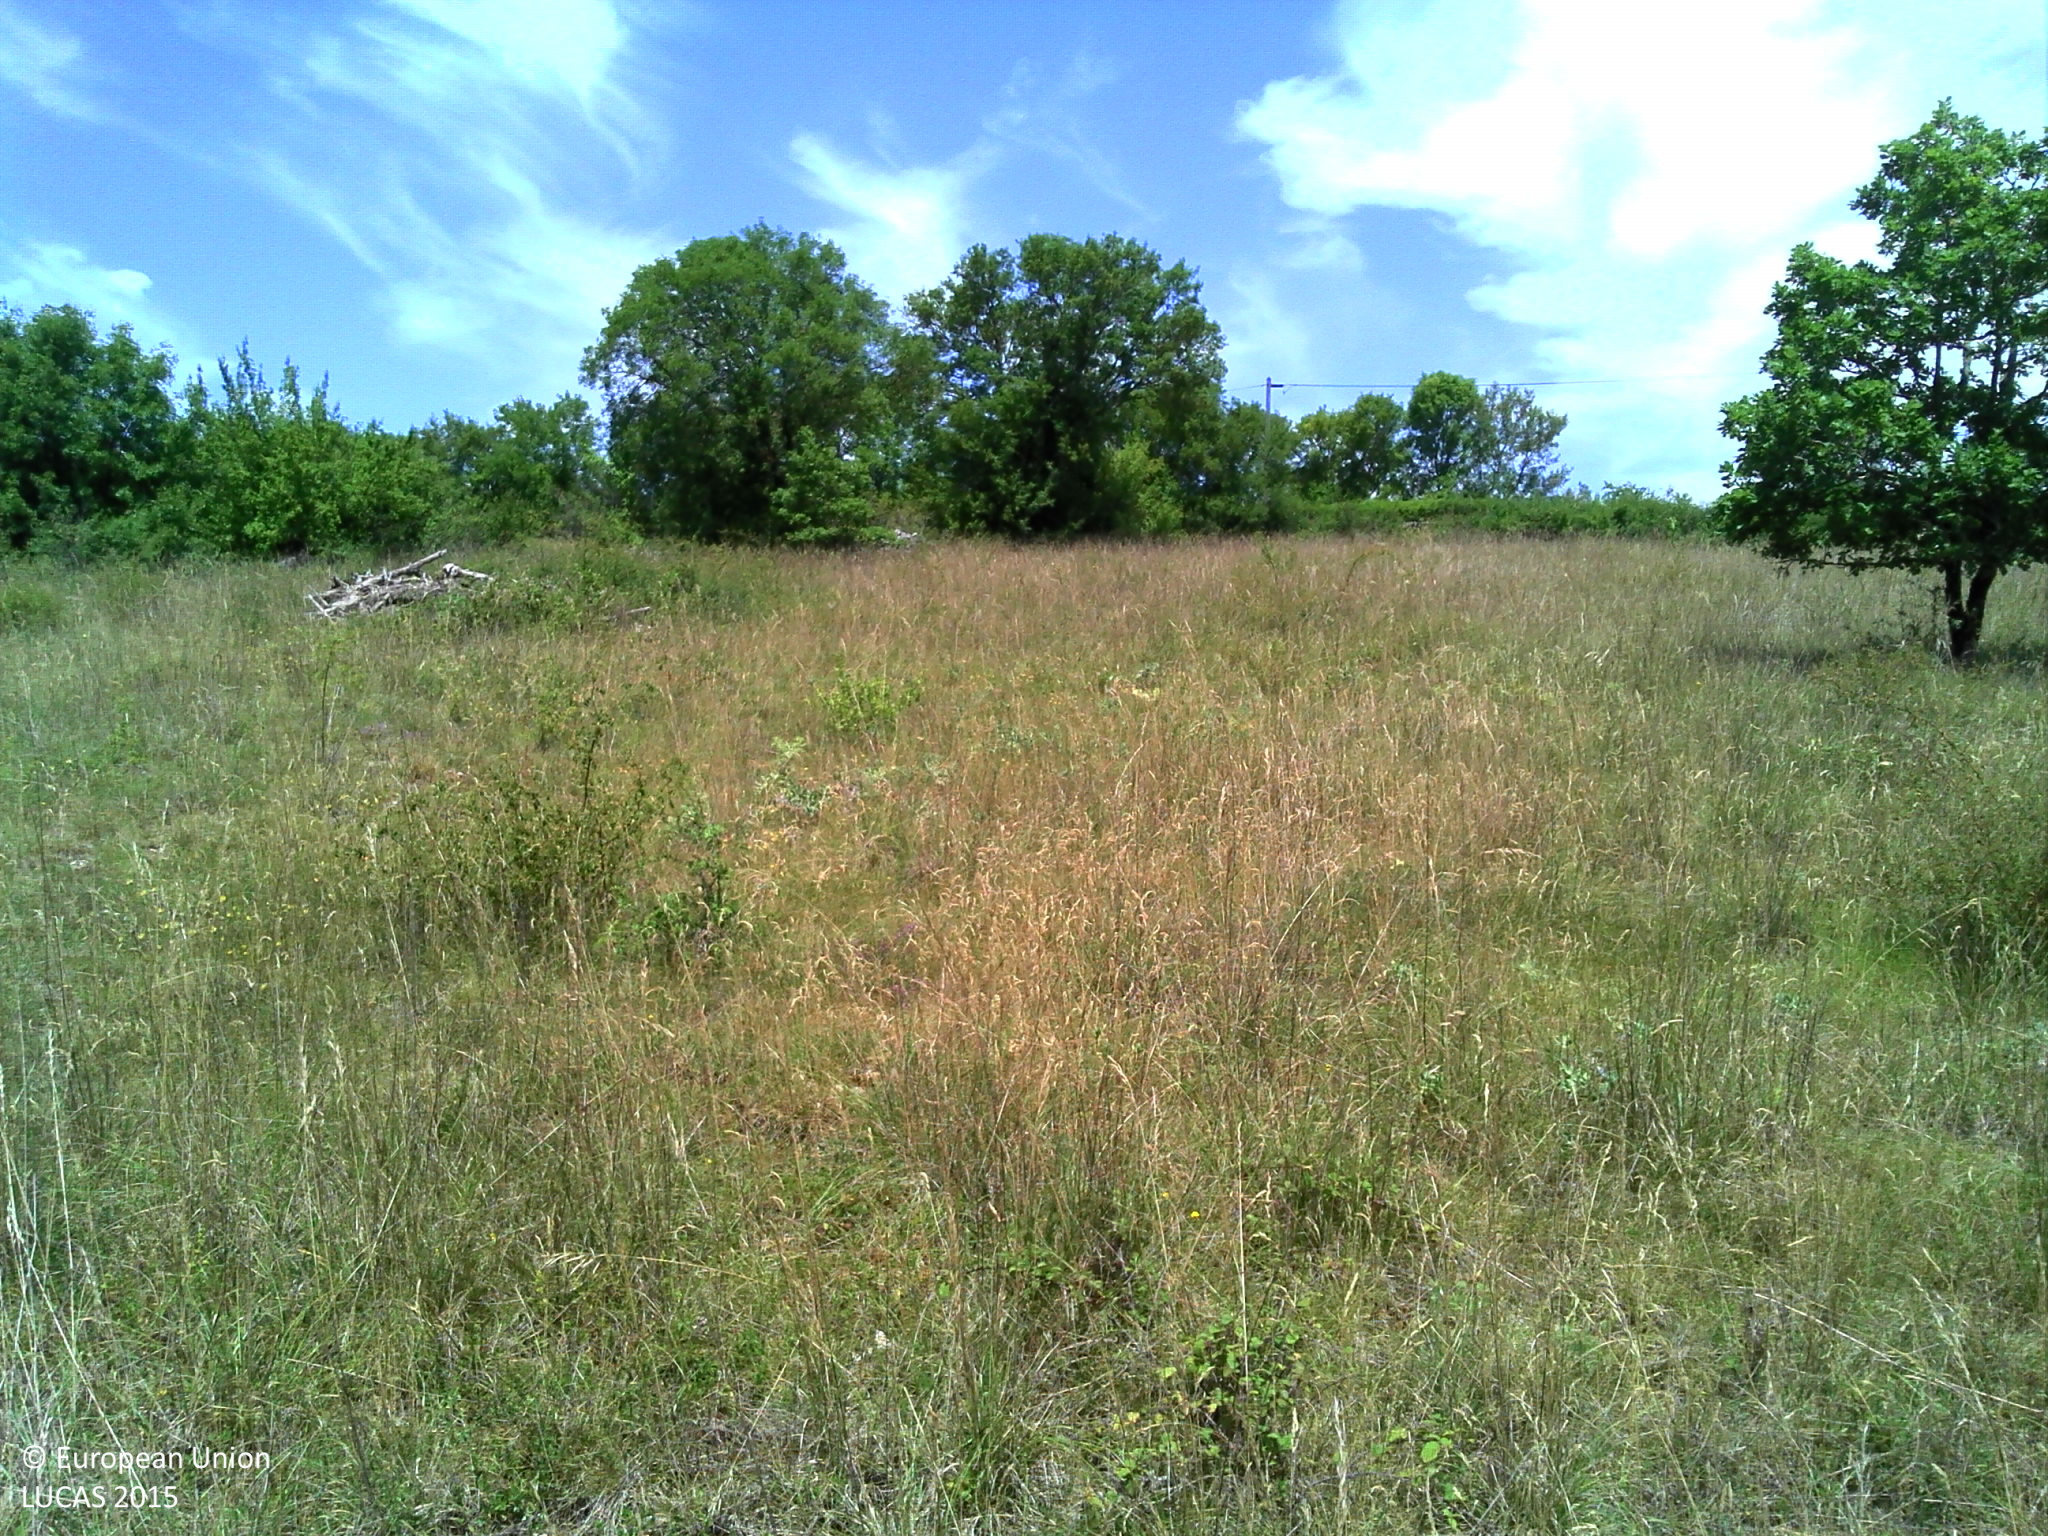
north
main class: Grassland
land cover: Grassland with sparse tree/shrub cover
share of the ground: > 75 %
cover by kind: herbaceous plants 95 %, broadleaved forest trees 5 %
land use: Agriculture (excluding fallow land and kitchen gardens)
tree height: < 5 m
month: June
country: FR
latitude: 44.7365
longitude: 1.6253
